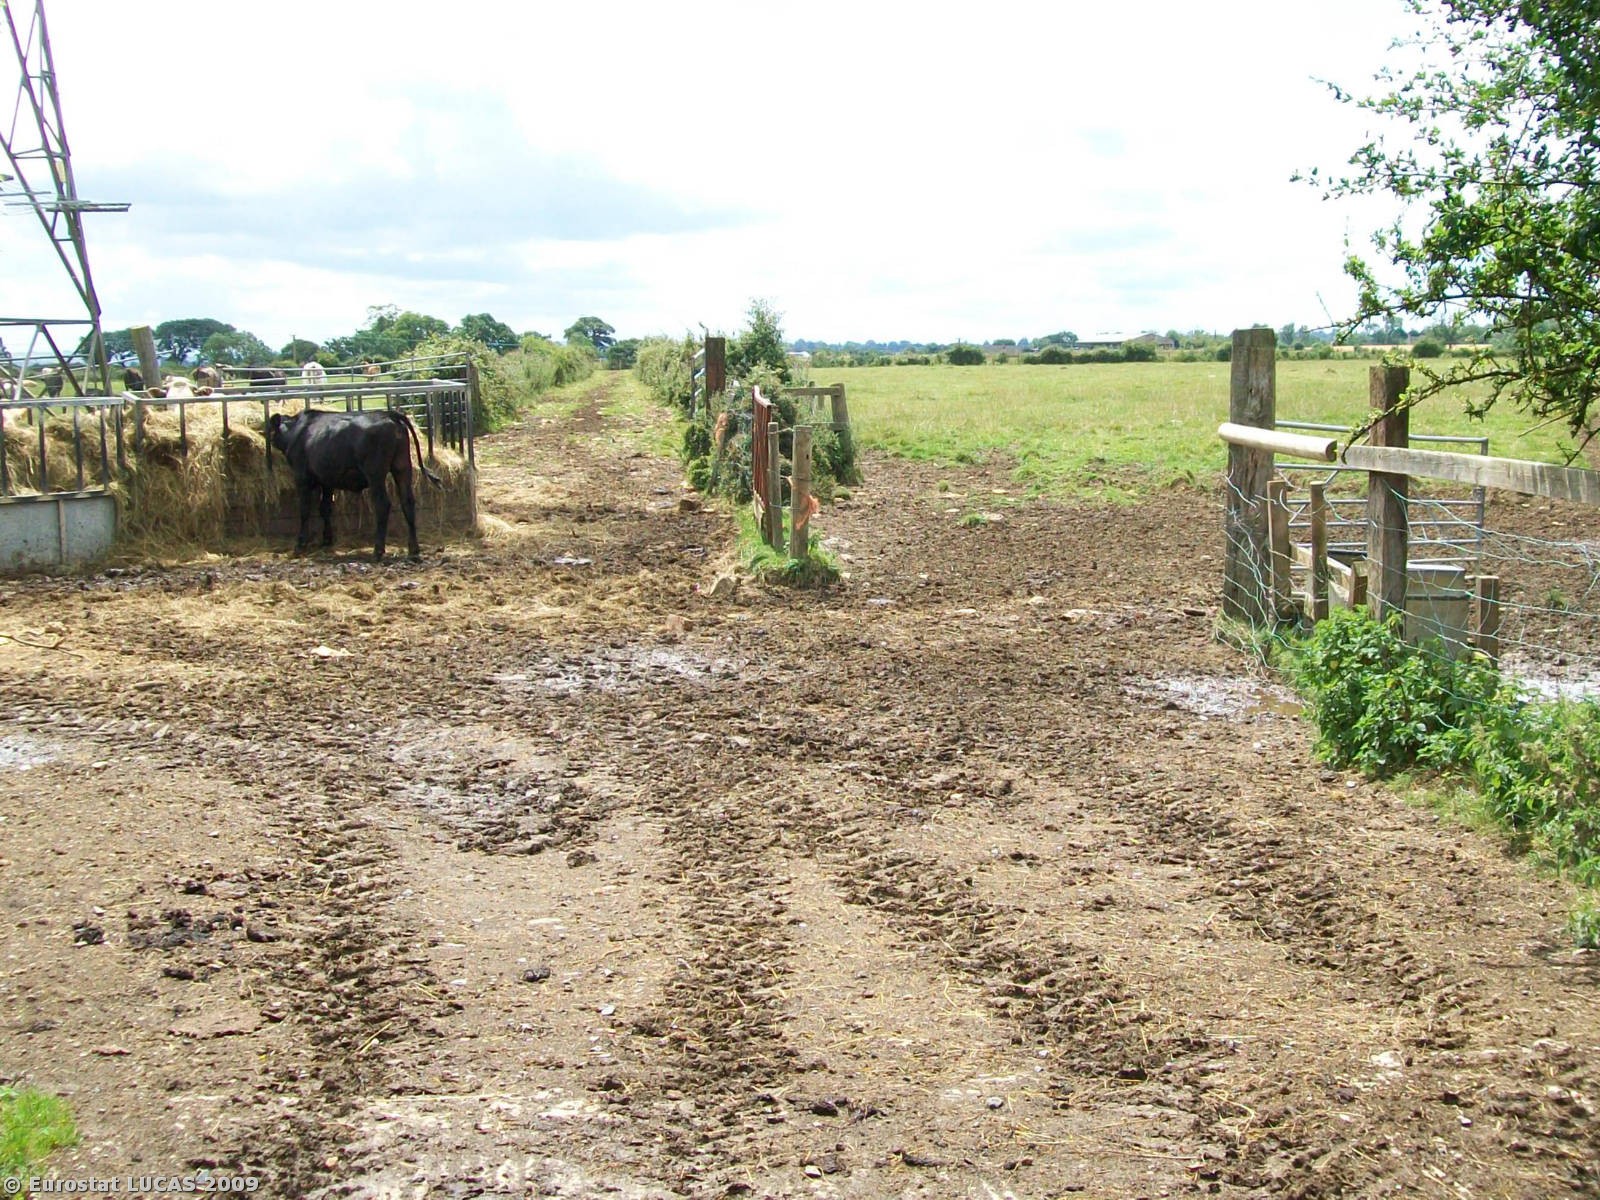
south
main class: Grassland
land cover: Grassland without tree/shrub cover
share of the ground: > 75 %
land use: Agriculture (excluding fallow land and kitchen gardens)
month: July
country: GB
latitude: 51.3959
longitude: -2.2358
